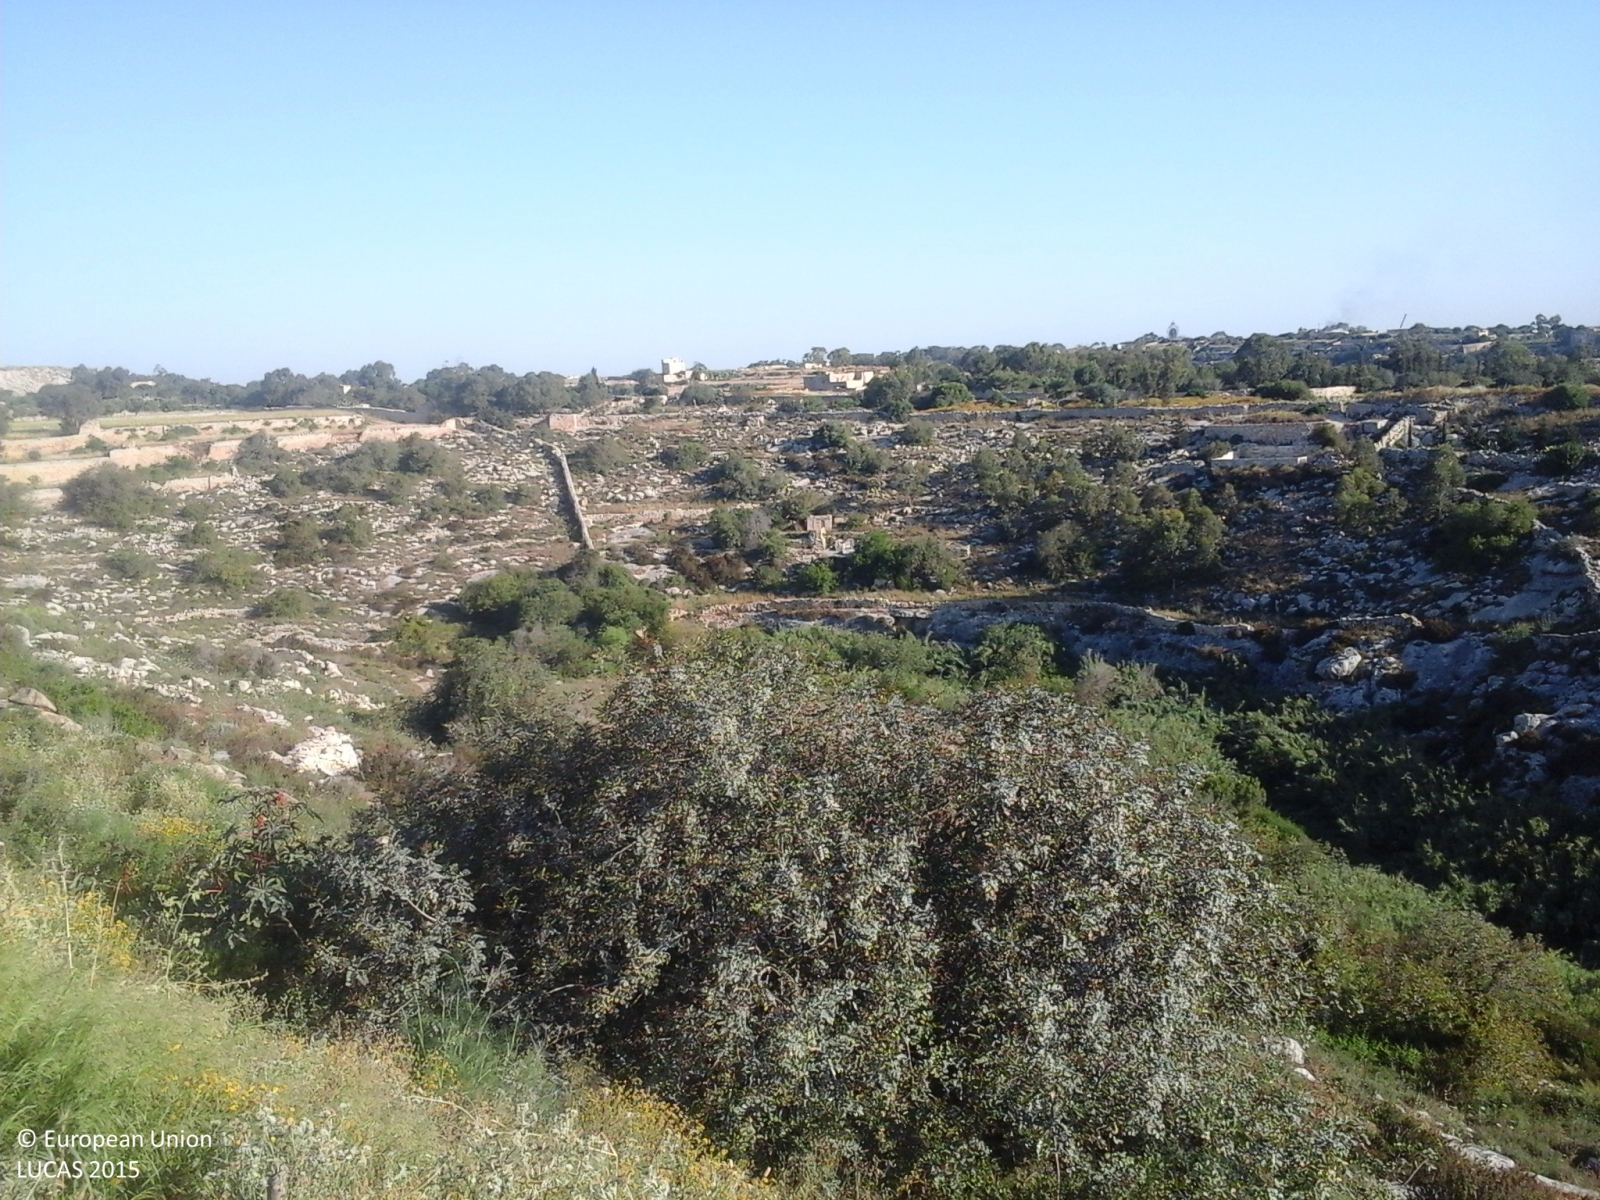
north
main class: Shrubland
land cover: Shrubland with sparse tree cover
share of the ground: > 75 %
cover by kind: shrubs 65 %, herbaceous plants 20 %, coniferous forest trees 5 %
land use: Semi-natural and natural areas not in use
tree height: > 5 m
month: May
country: MT
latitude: 35.8592
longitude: 14.4656
